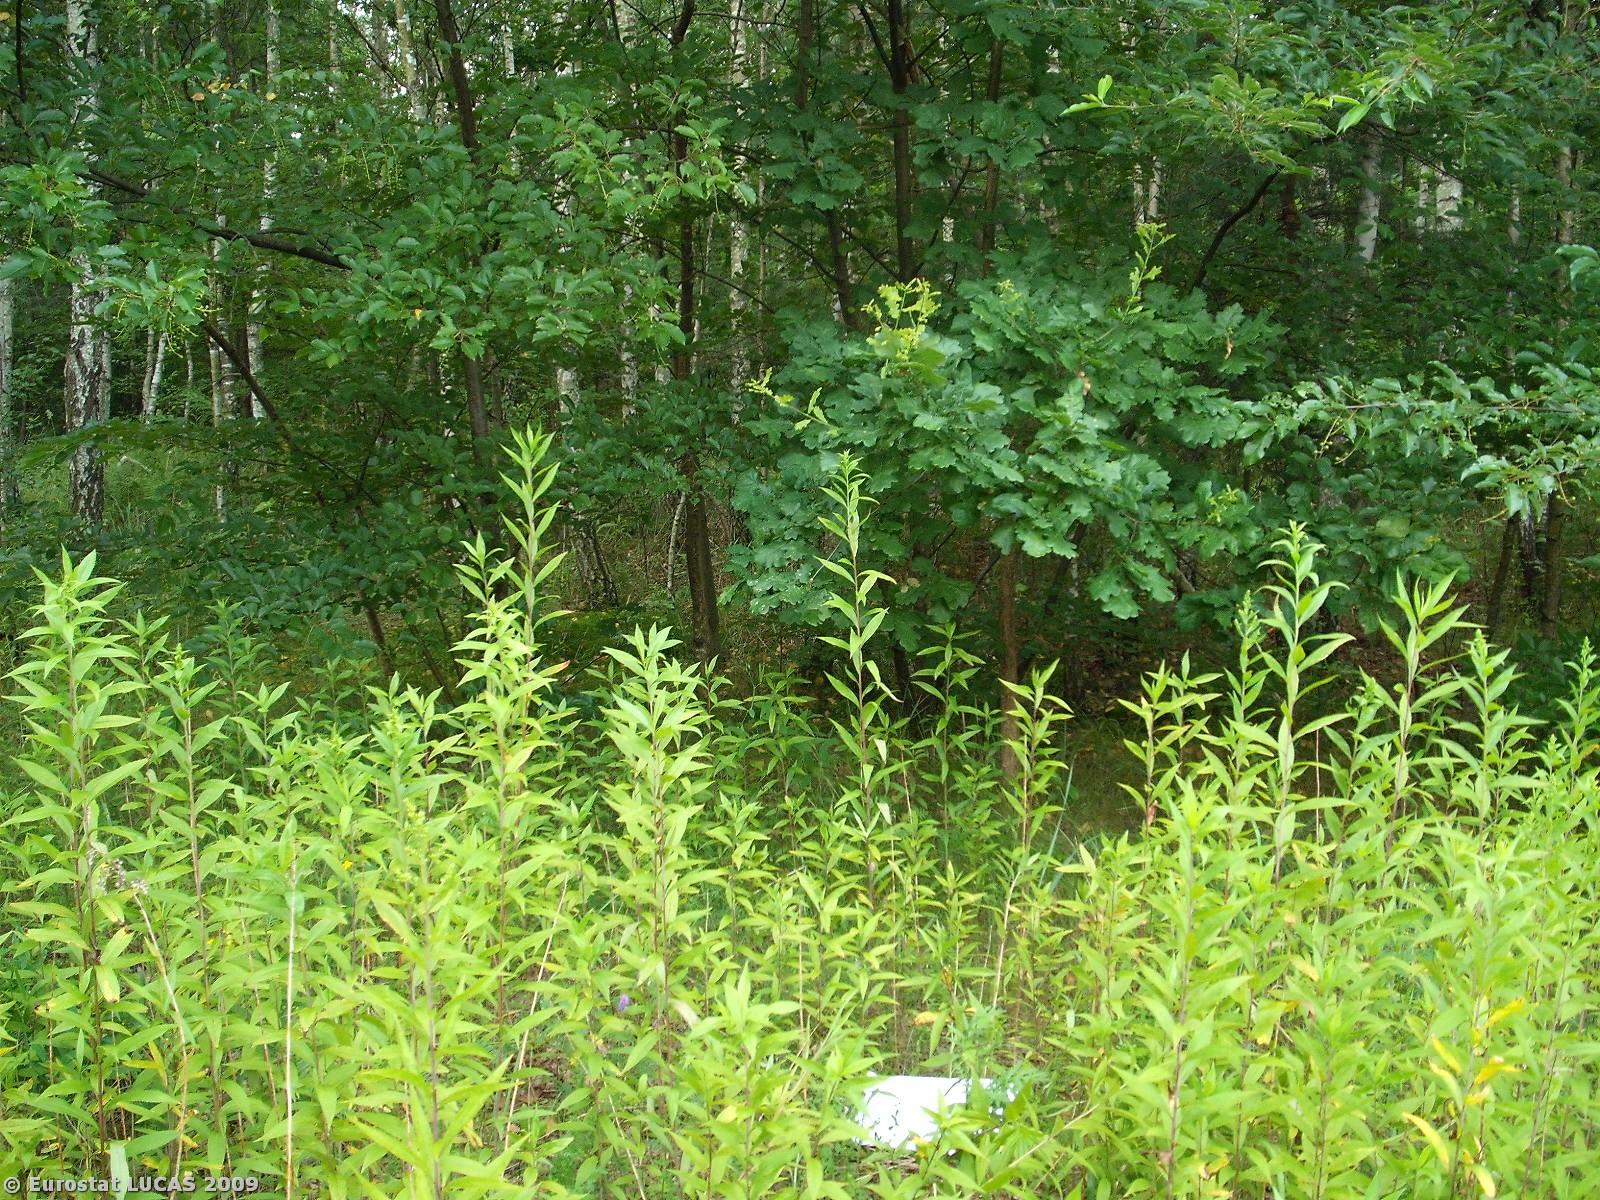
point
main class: Woodland
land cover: Broadleaved woodland
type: mesophytic deciduous forest
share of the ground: 25 - 50 %
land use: Forestry
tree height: > 5 m
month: July
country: PL
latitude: 52.1161
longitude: 21.2191
